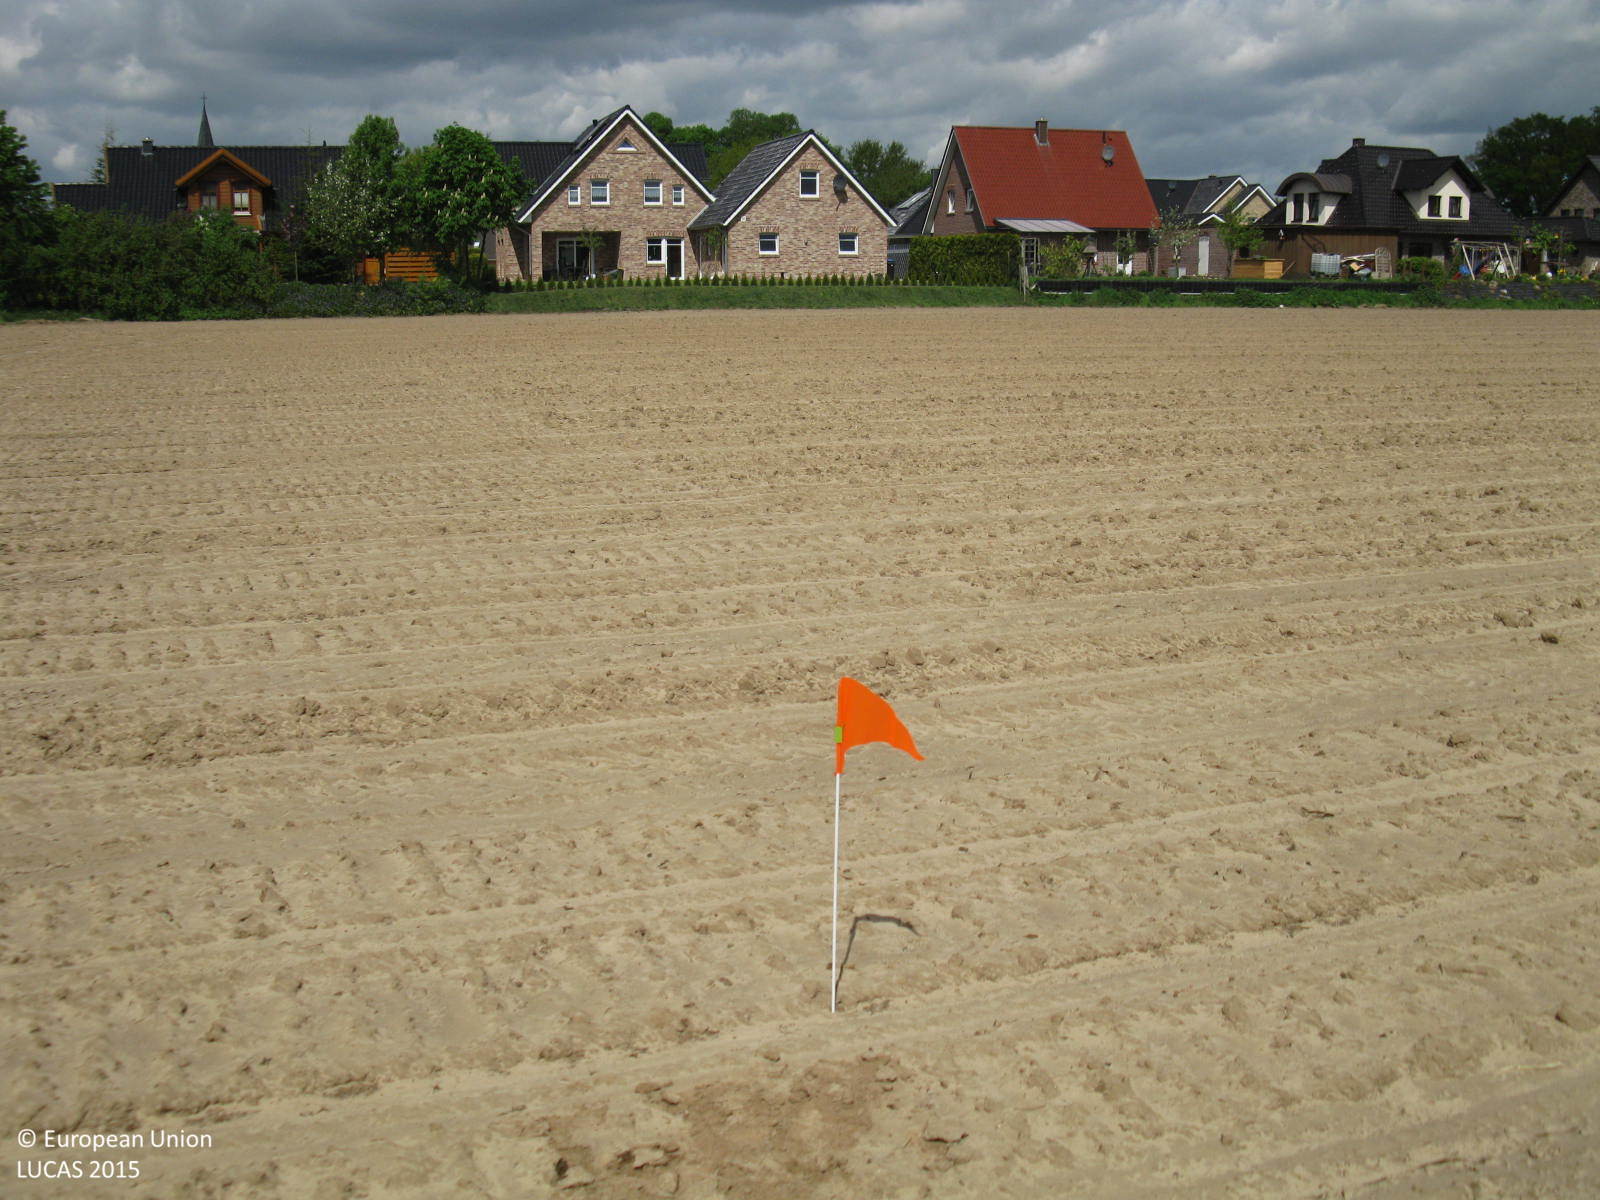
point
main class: Cropland
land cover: Maize
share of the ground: < 10 %
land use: Agriculture (excluding fallow land and kitchen gardens)
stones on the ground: < 10 %
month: May
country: DE
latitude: 52.9225
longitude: 7.3083
